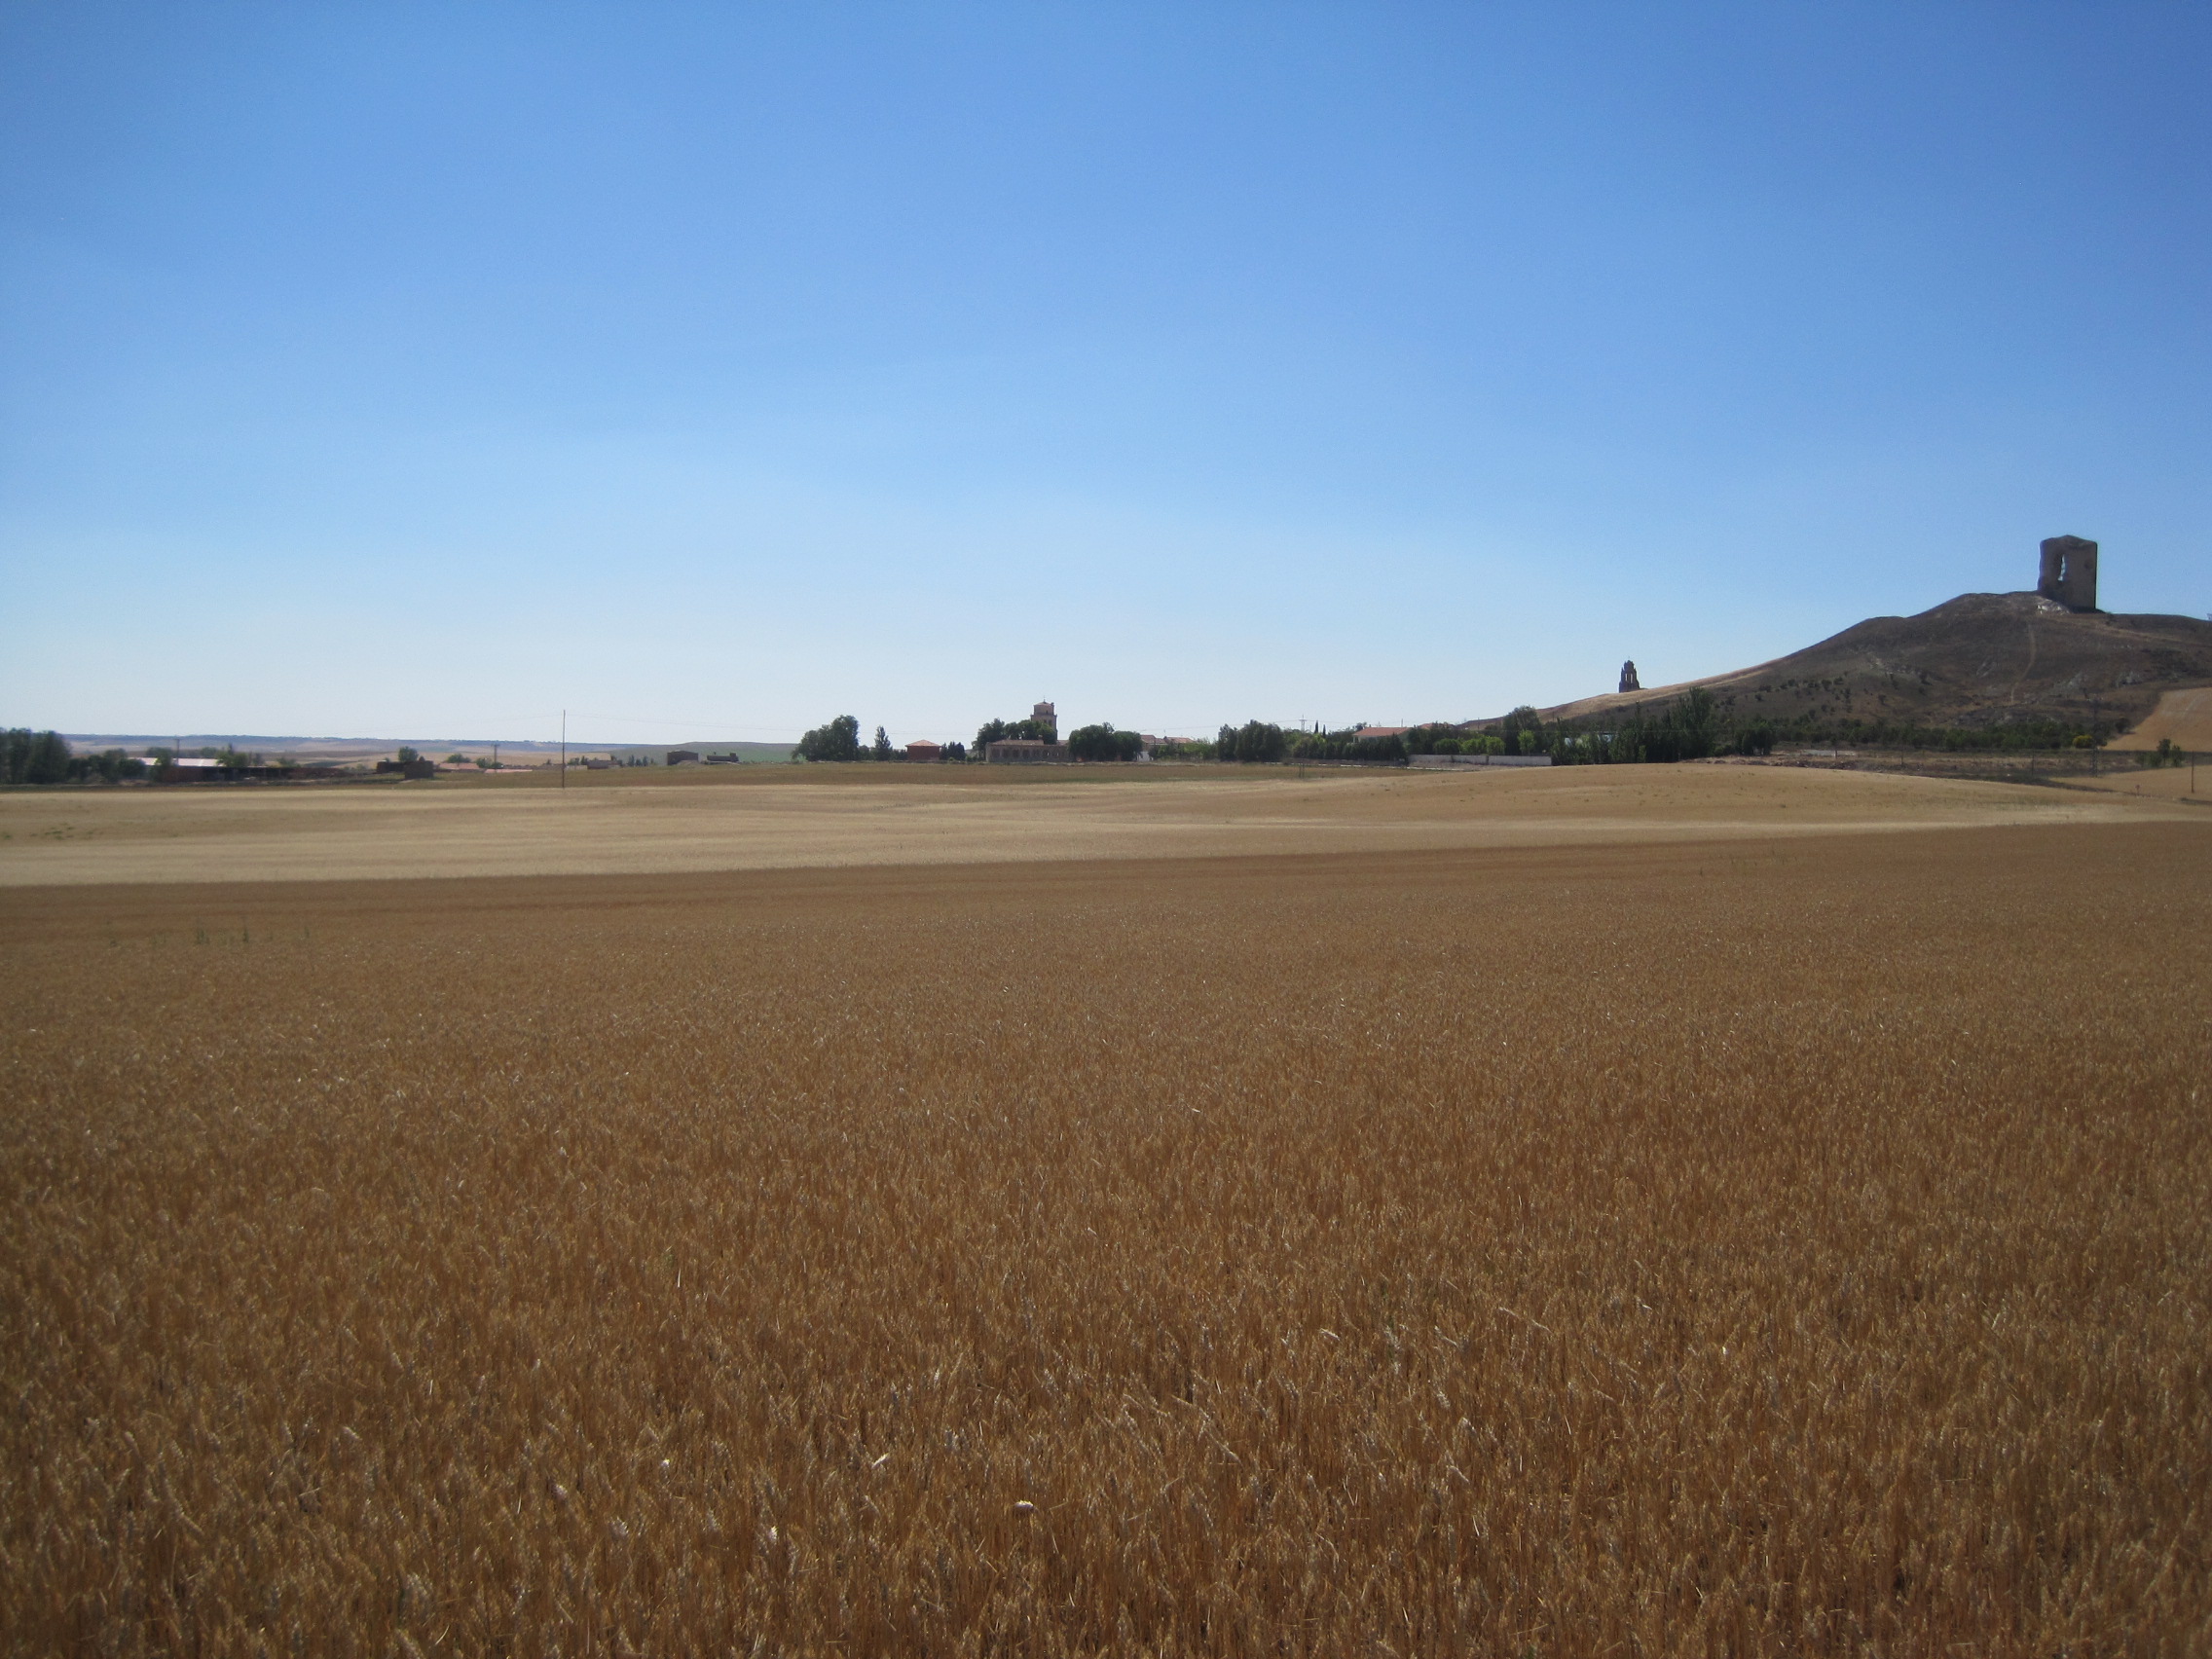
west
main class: Cropland
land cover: Common wheat
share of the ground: > 75 %
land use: Agriculture (excluding fallow land and kitchen gardens)
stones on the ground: 10 - 25 %
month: June
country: ES
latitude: 41.6328
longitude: -5.1659
